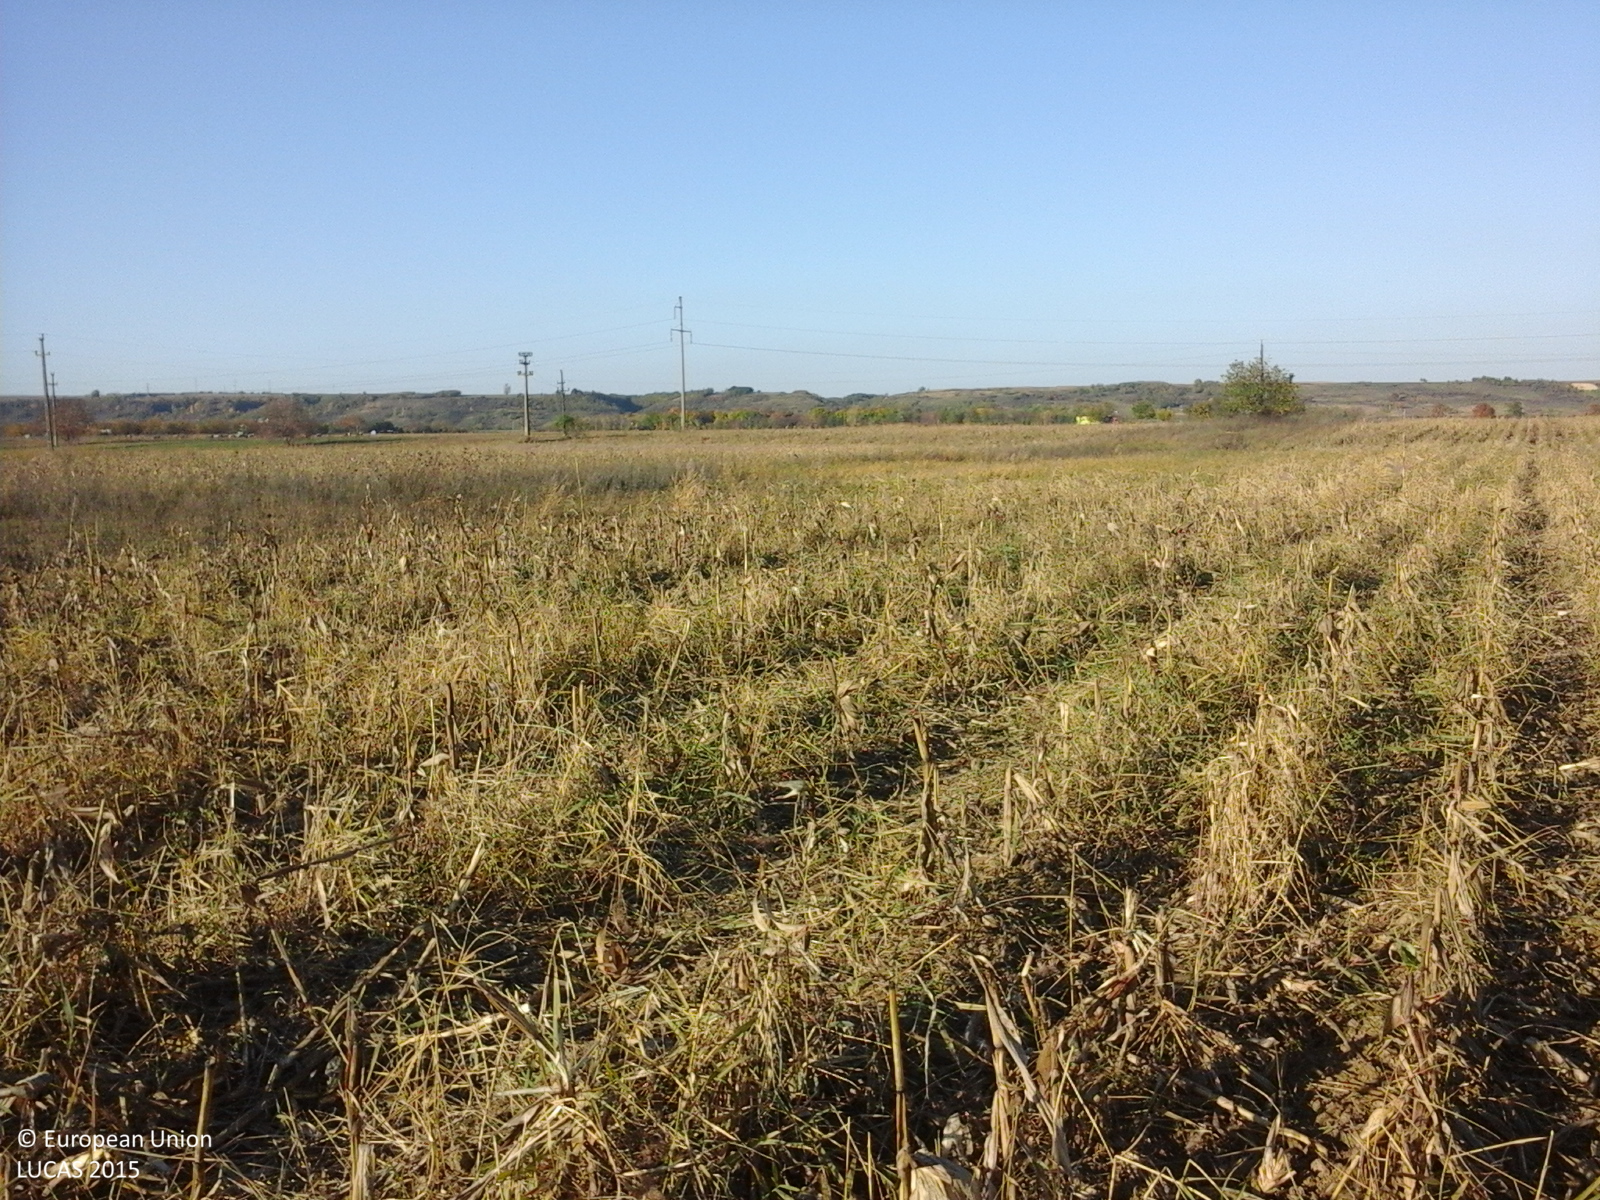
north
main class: Cropland
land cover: Maize
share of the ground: 25 - 50 %
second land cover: Spontaneously vegetated surfaces
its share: 50 - 75 %
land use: Agriculture (excluding fallow land and kitchen gardens)
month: October
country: RO
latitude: 46.1179
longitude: 27.1122
